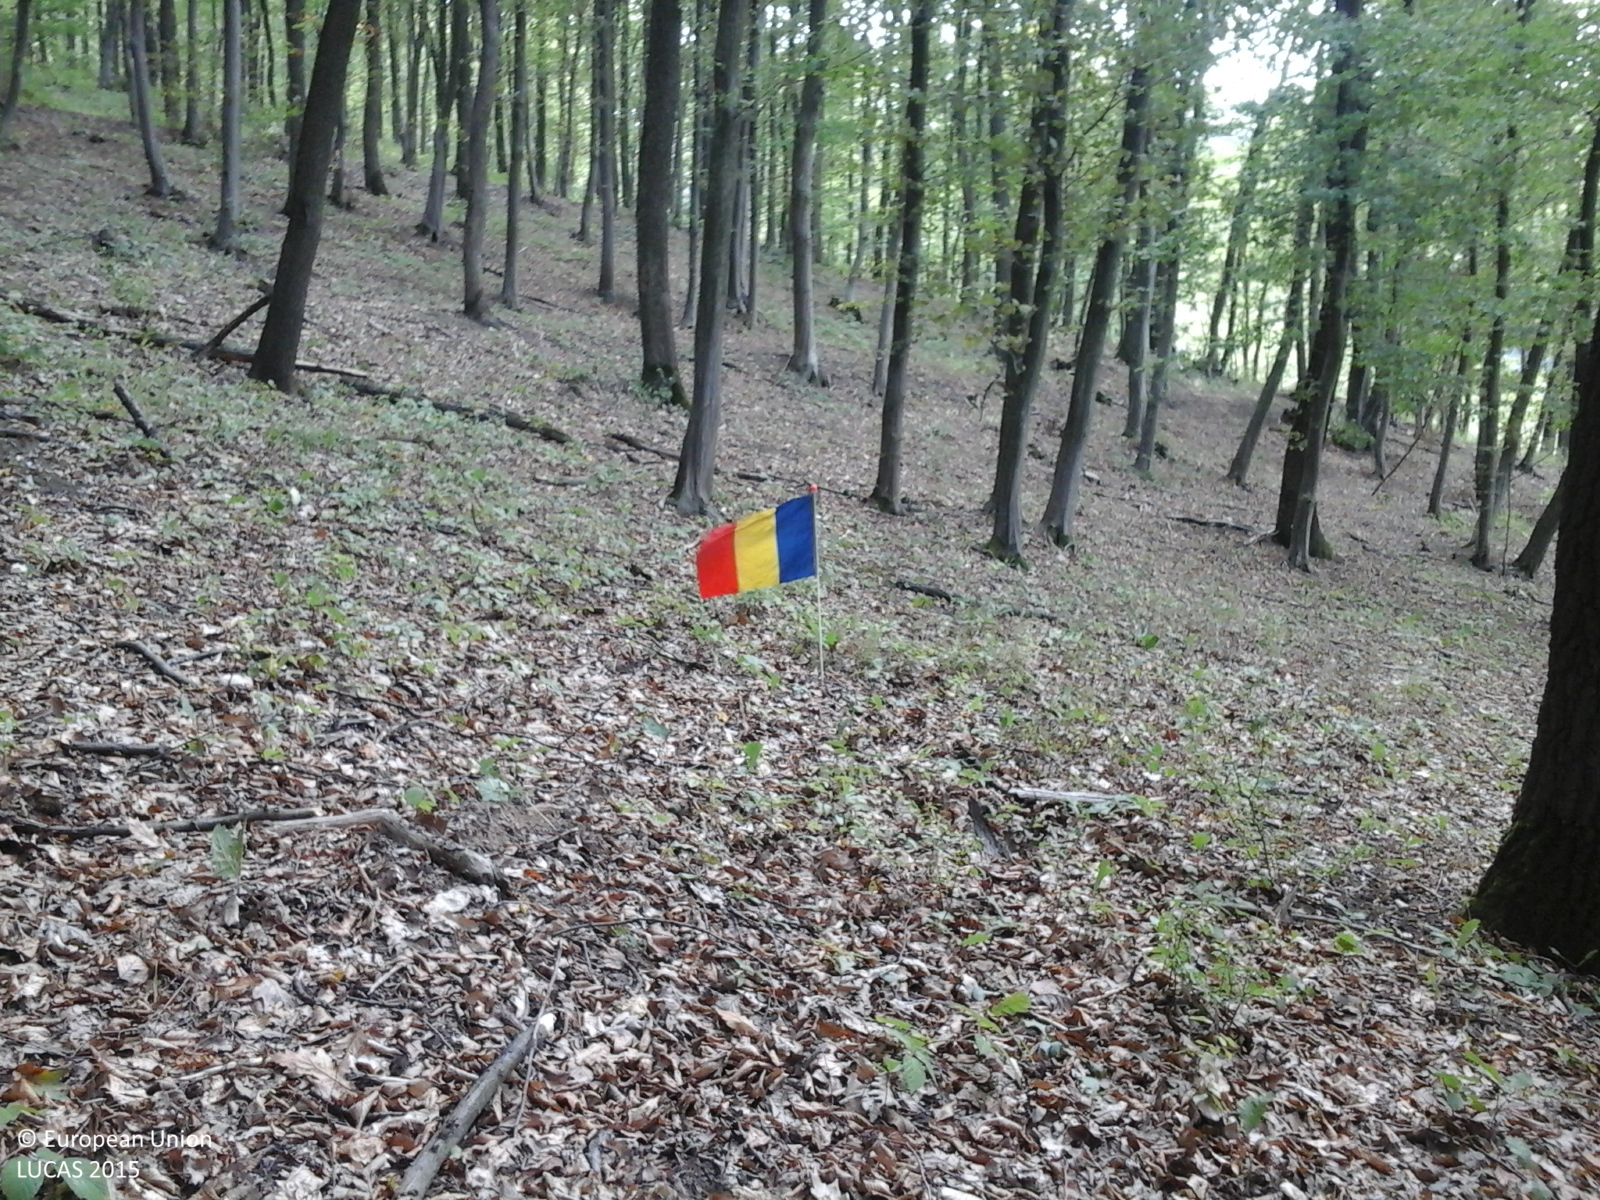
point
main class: Woodland
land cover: Broadleaved woodland
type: acidophilous oak and oak-birch forest
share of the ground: > 75 %
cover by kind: broadleaved forest trees 100 %
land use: Forestry
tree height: > 5 m
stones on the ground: < 10 %
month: September
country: RO
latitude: 45.9387
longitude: 22.8353
